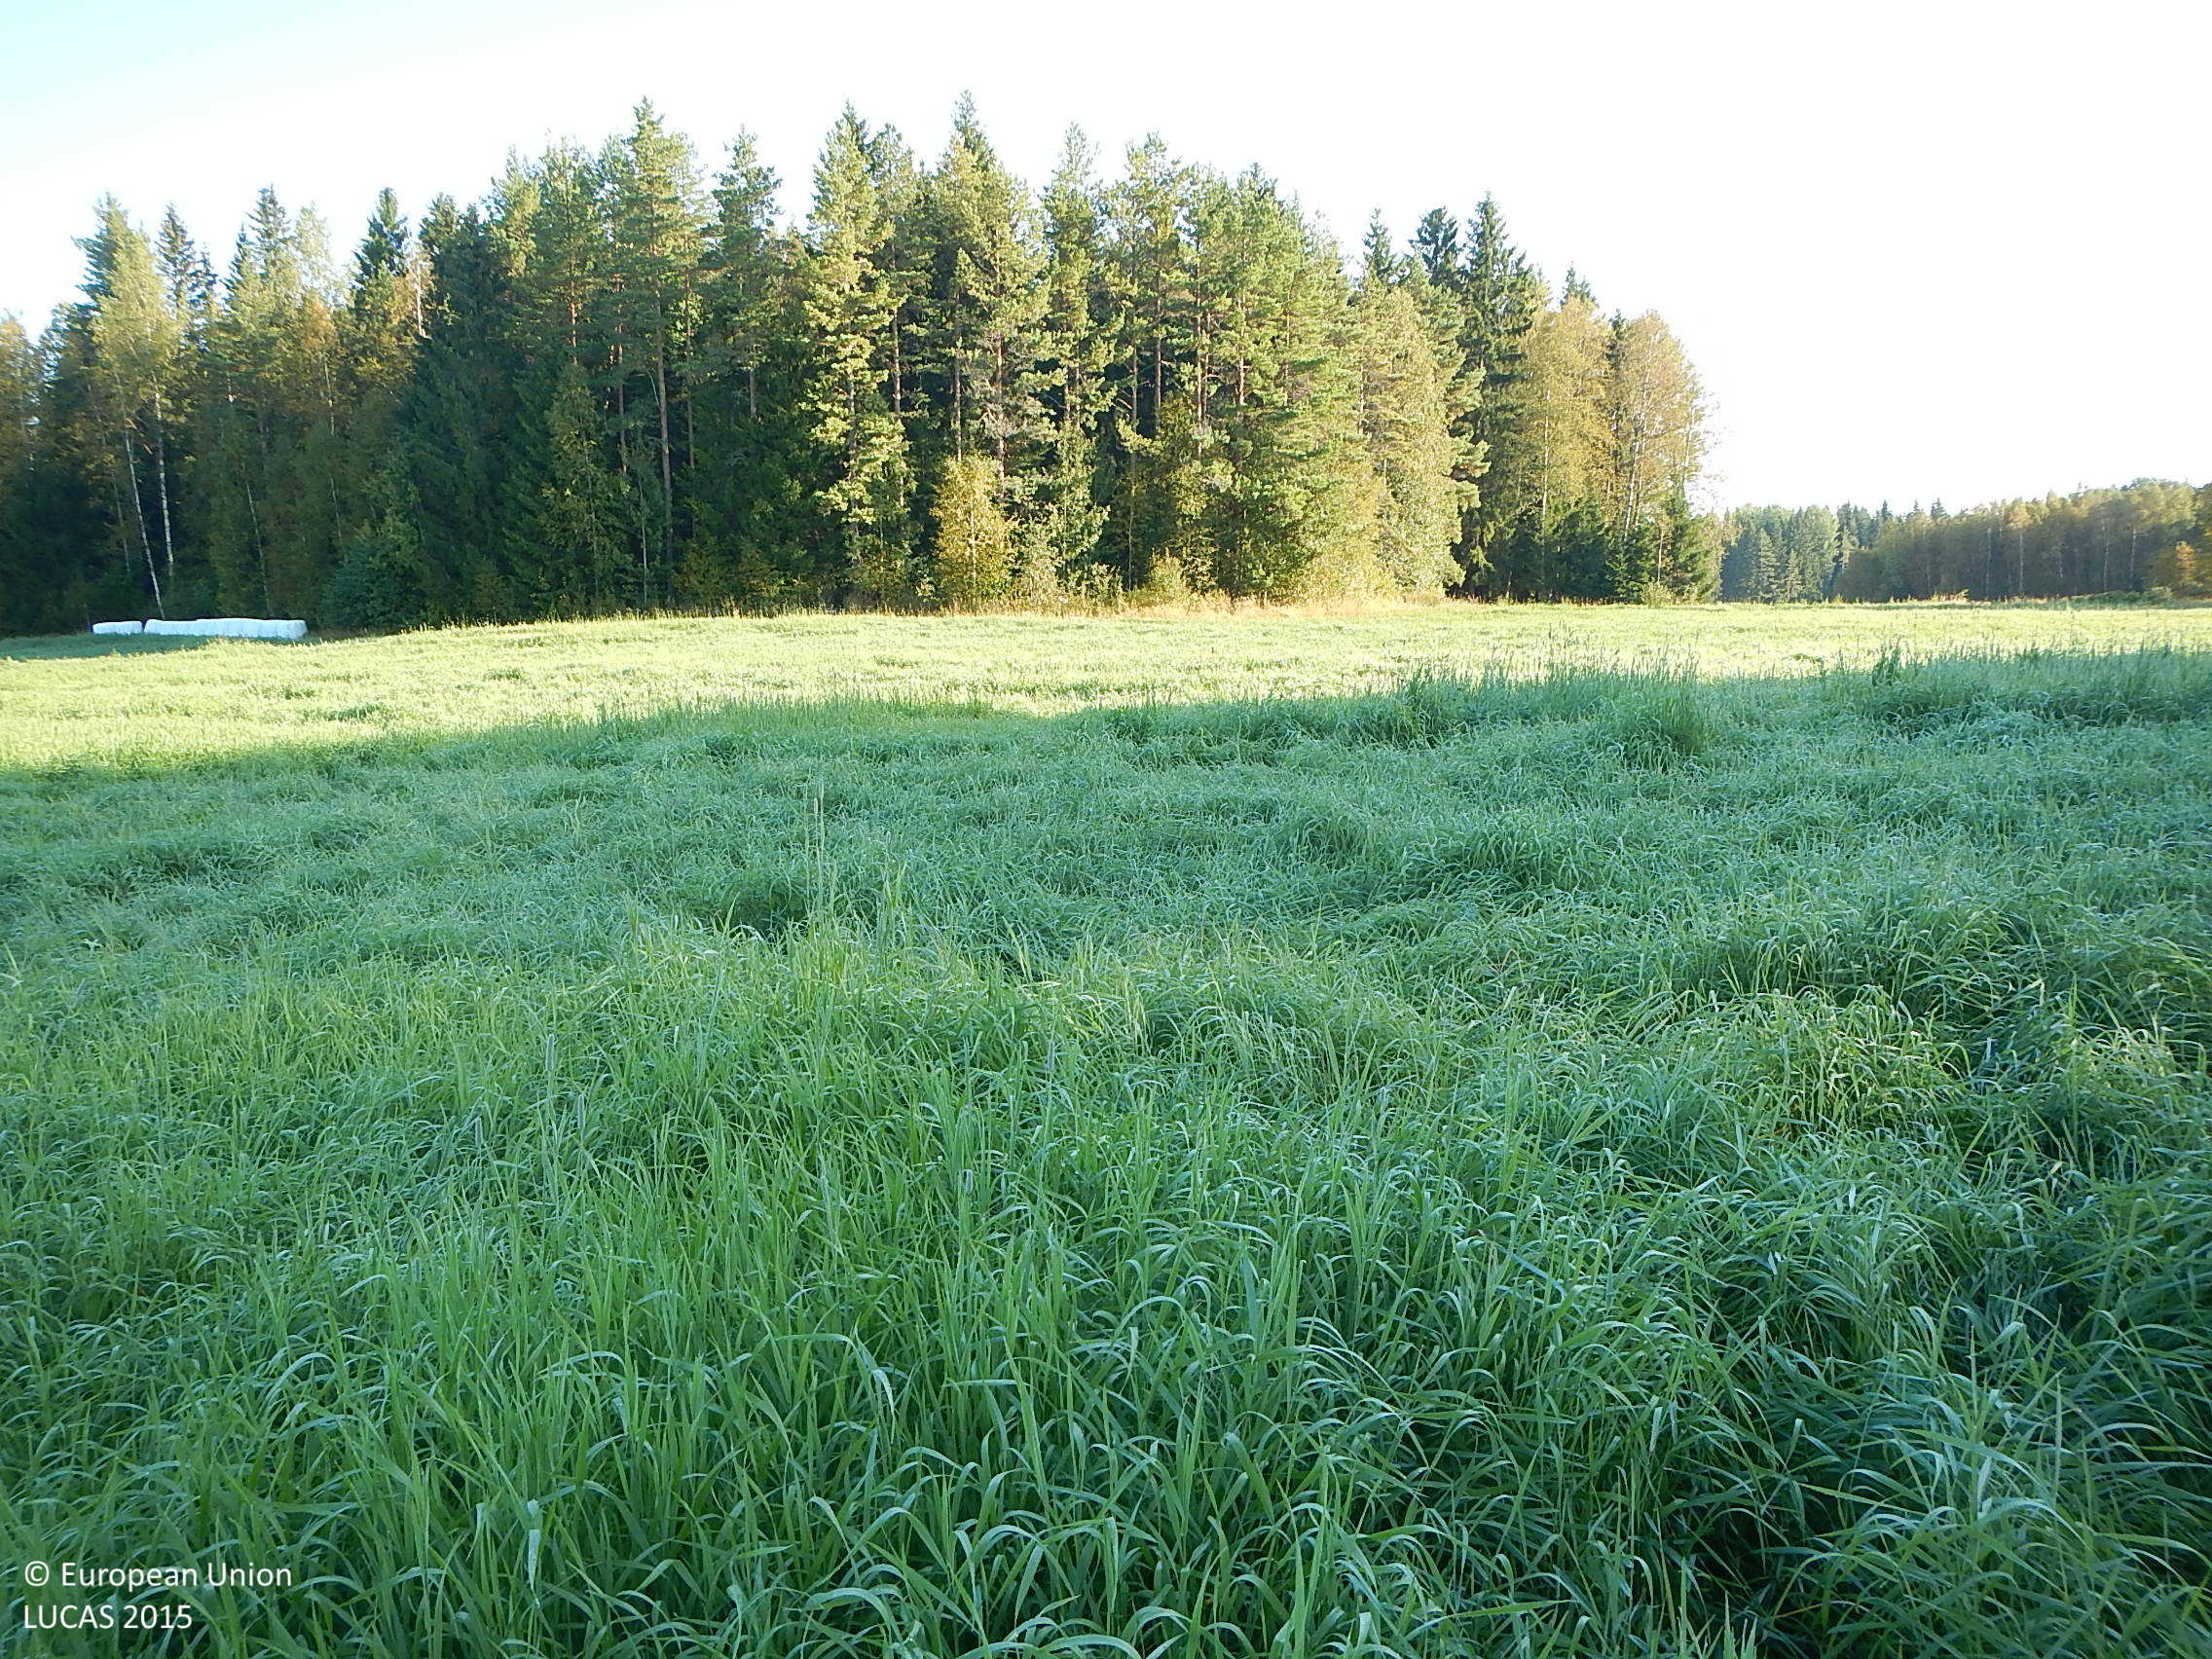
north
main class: Cropland
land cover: Temporary grasslands
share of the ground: > 75 %
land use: Agriculture (excluding fallow land and kitchen gardens)
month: September
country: FI
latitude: 61.6458
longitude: 22.1183
